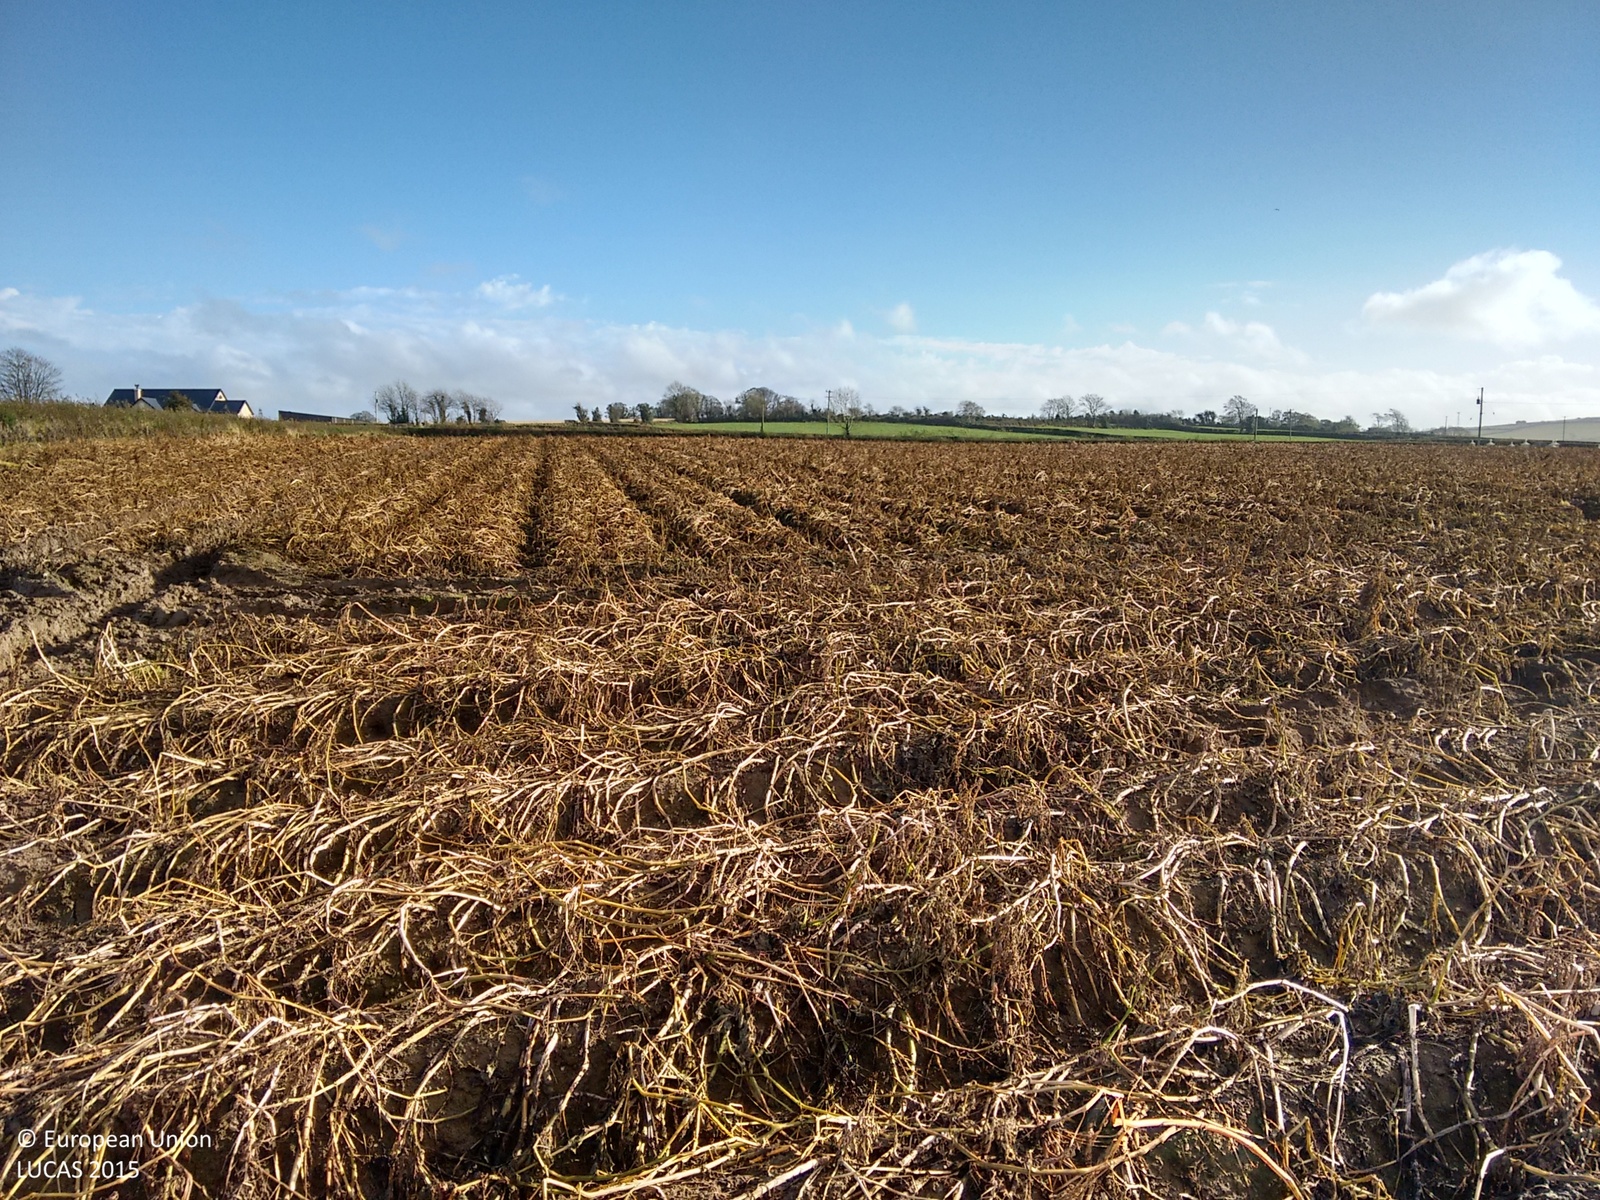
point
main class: Cropland
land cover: Potatoes
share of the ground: 10 - 25 %
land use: Agriculture (excluding fallow land and kitchen gardens)
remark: Harvested field
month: November
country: IE
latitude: 54.8562
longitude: -7.5241
